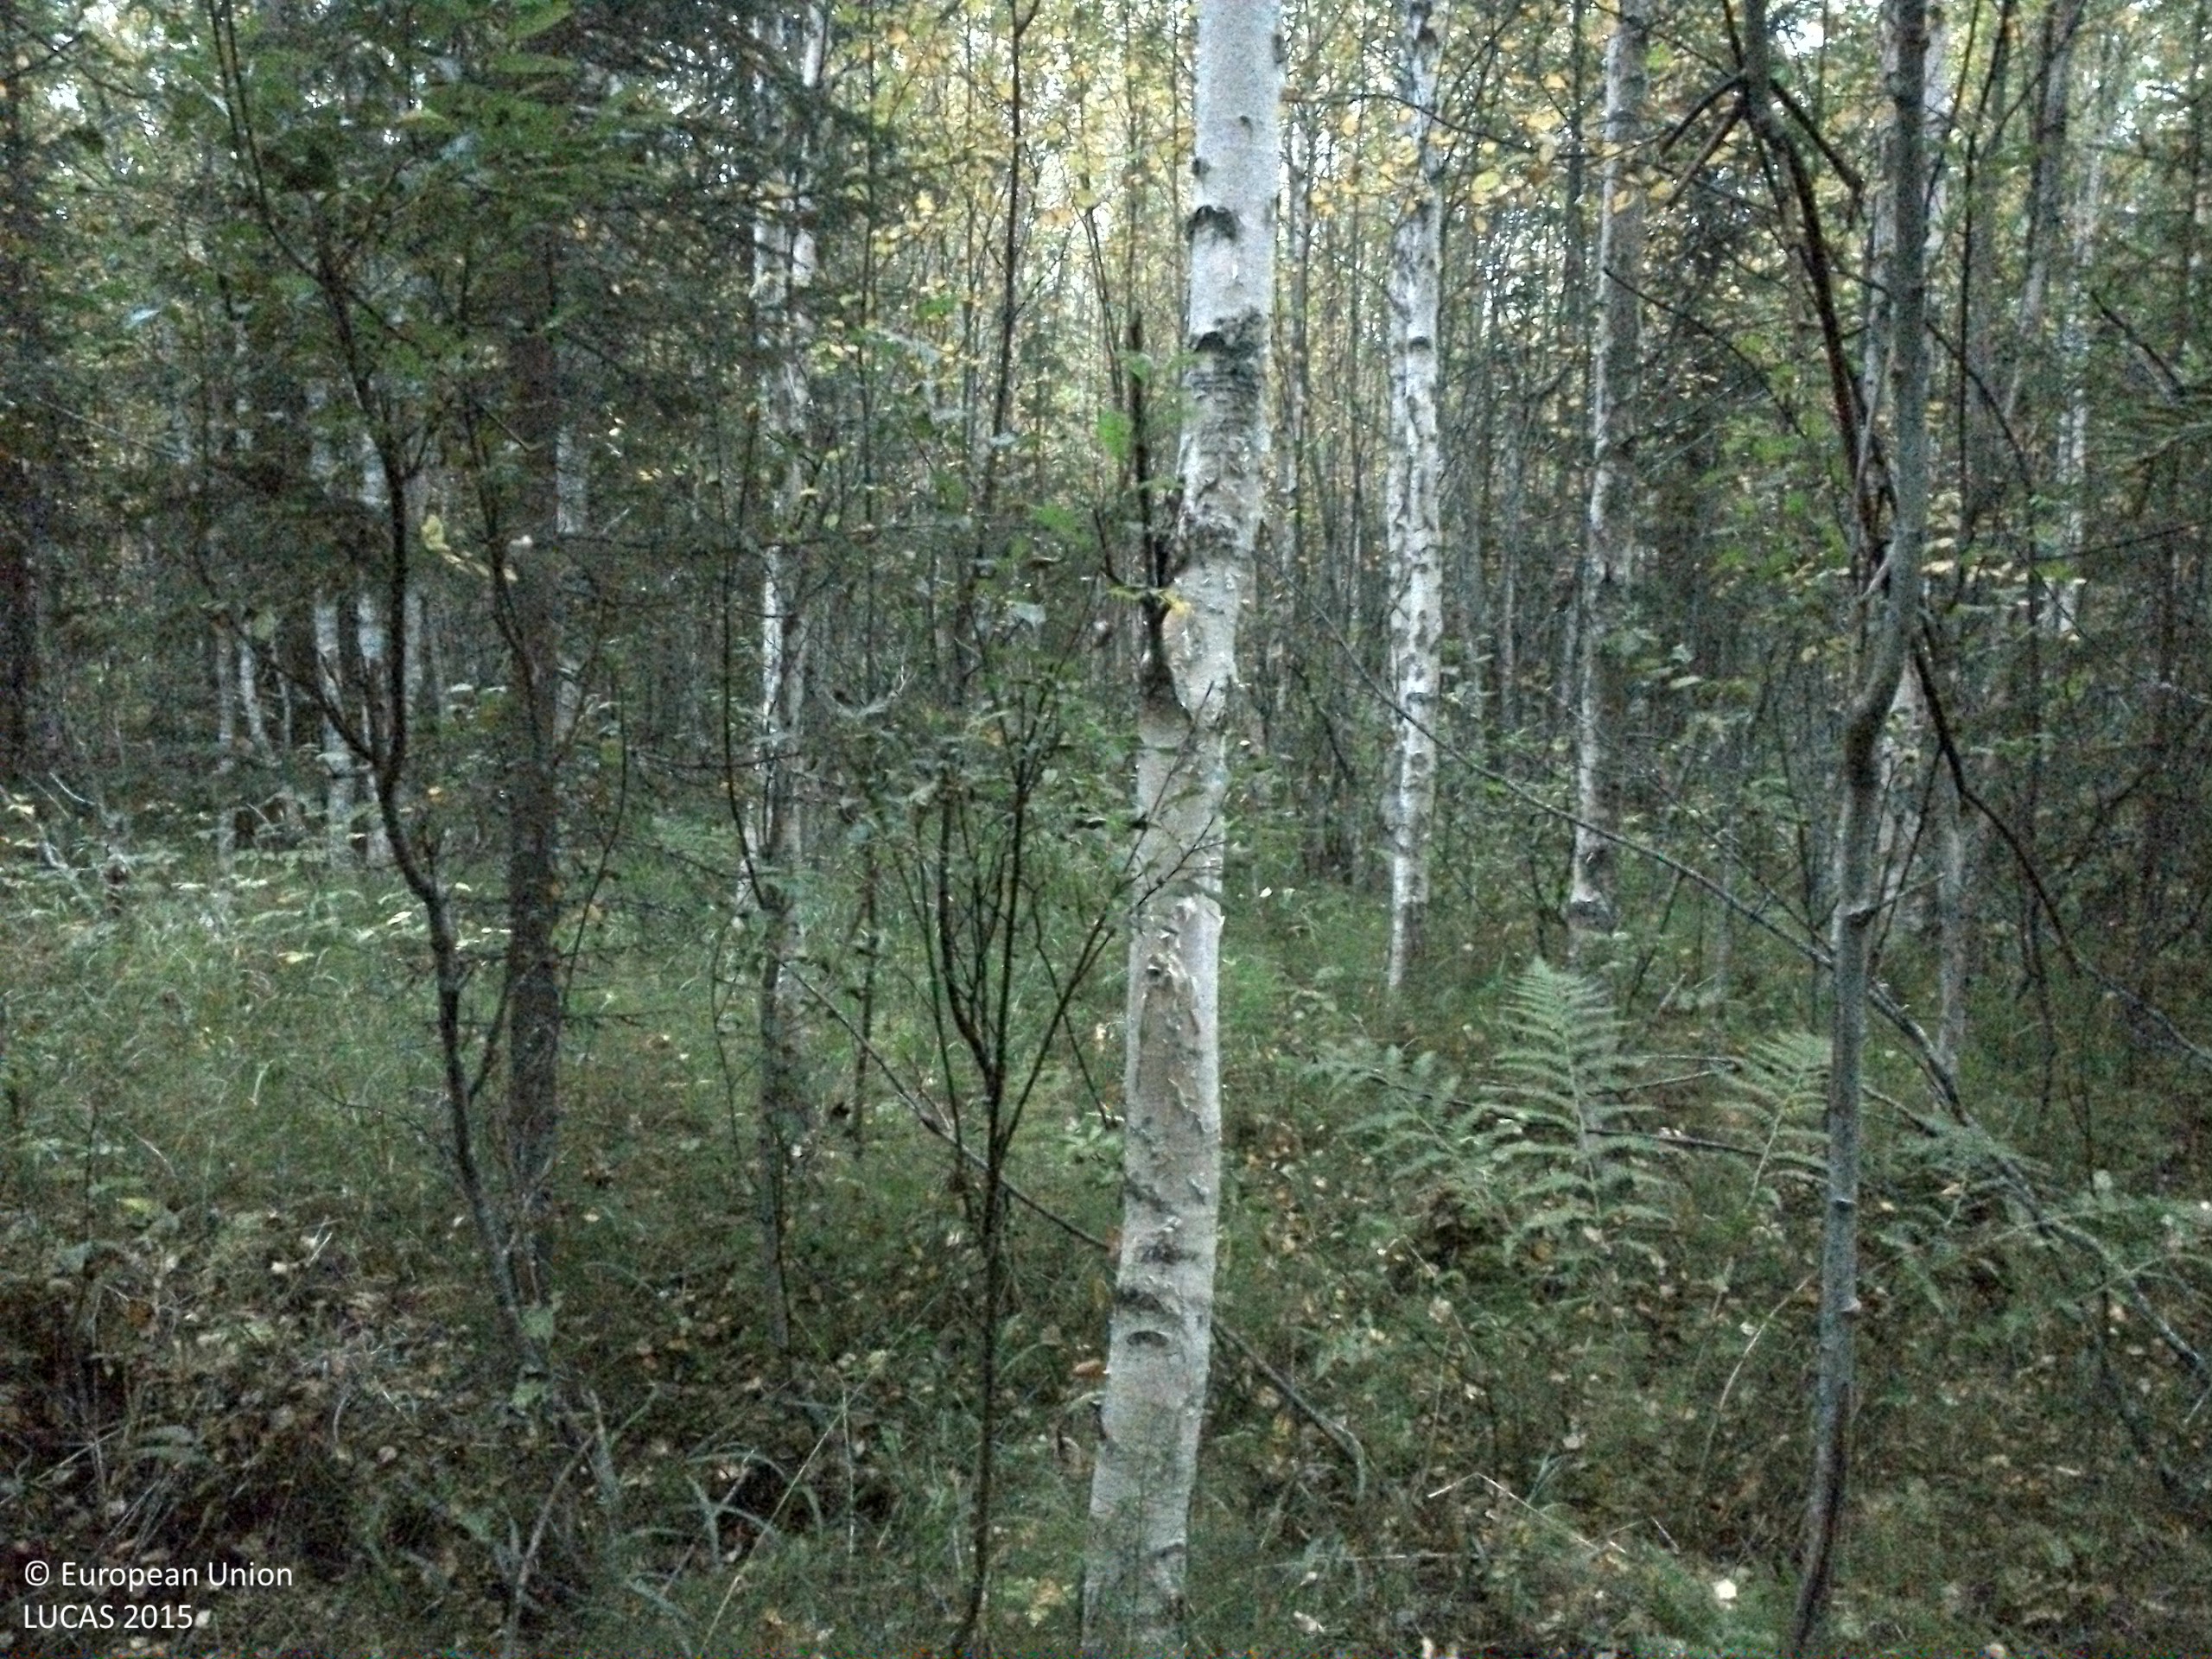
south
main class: Woodland
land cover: Spruce dominated mixed woodland
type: boreal forest
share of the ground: > 75 %
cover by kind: coniferous forest trees 50 %, broadleaved forest trees 25 %, shrubs 10 %, herbaceous plants 10 %, lichens and mosses 5 %
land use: Forestry
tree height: > 5 m
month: September
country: SE
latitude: 63.6161
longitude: 15.9641
